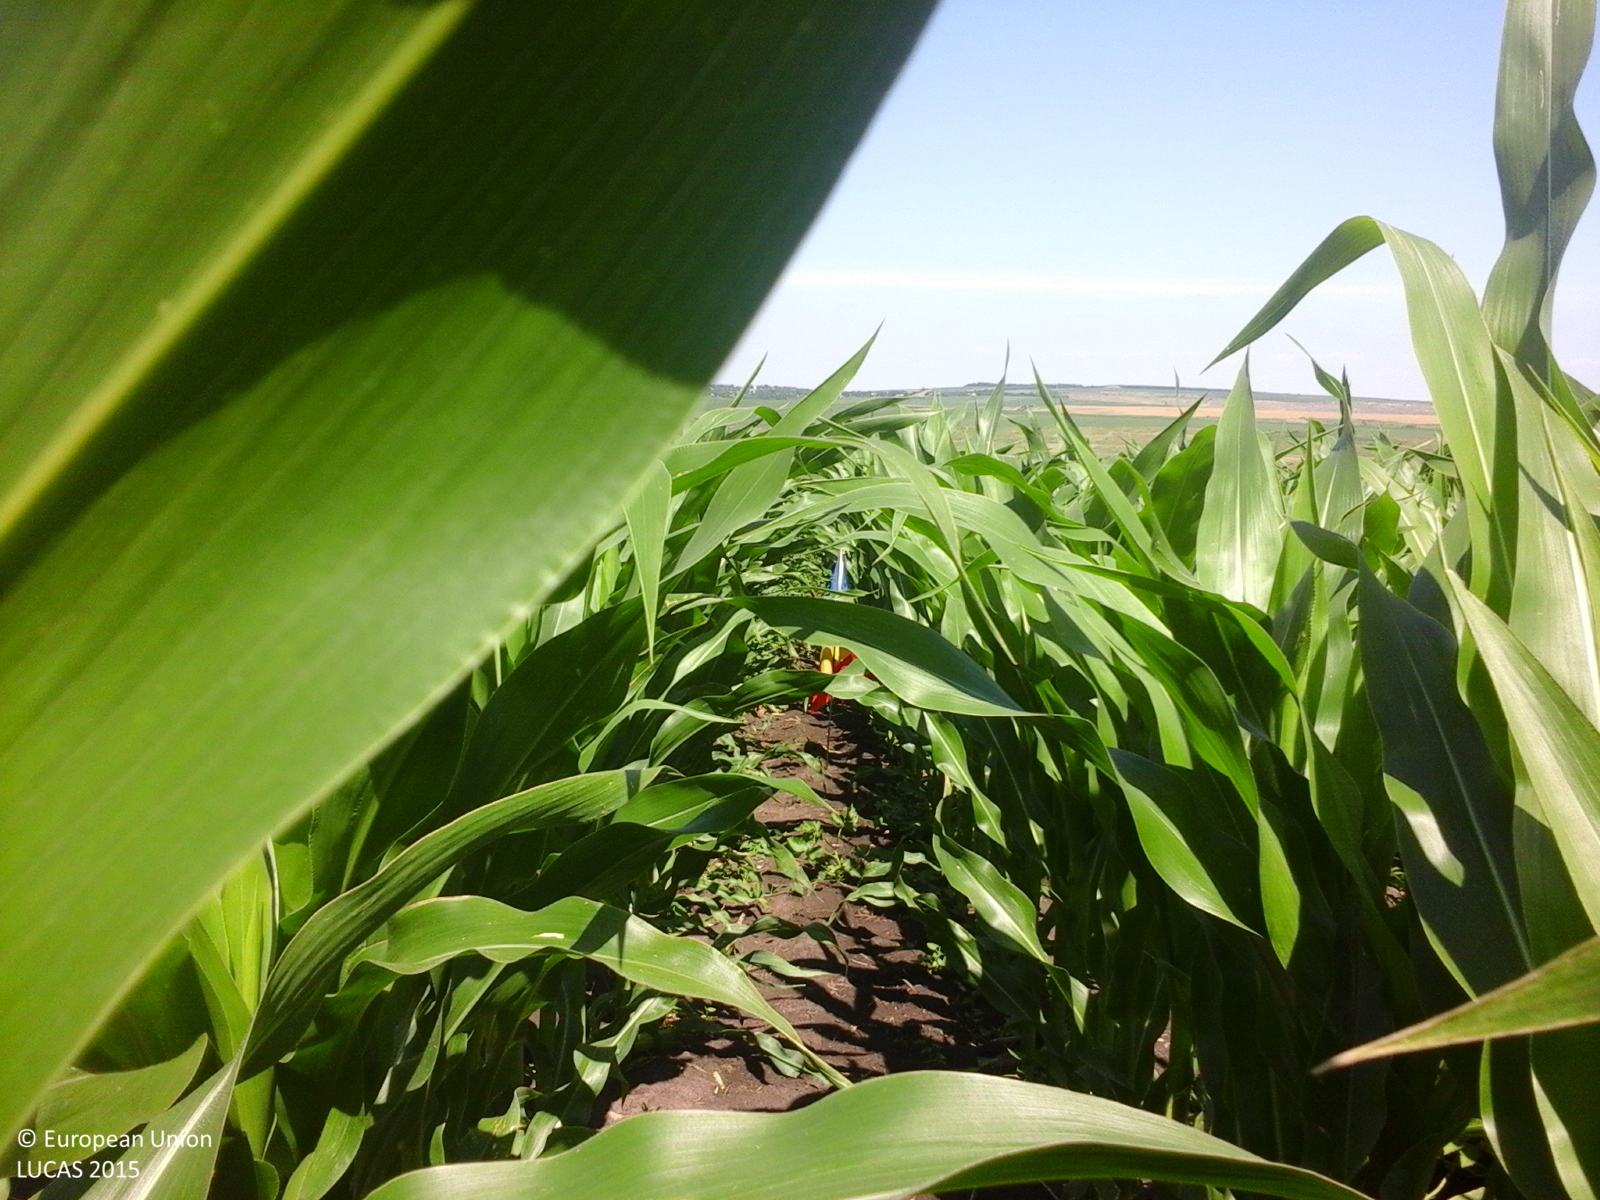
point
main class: Cropland
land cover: Maize
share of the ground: > 75 %
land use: Agriculture (excluding fallow land and kitchen gardens)
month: June
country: RO
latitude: 47.5284
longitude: 27.1490
